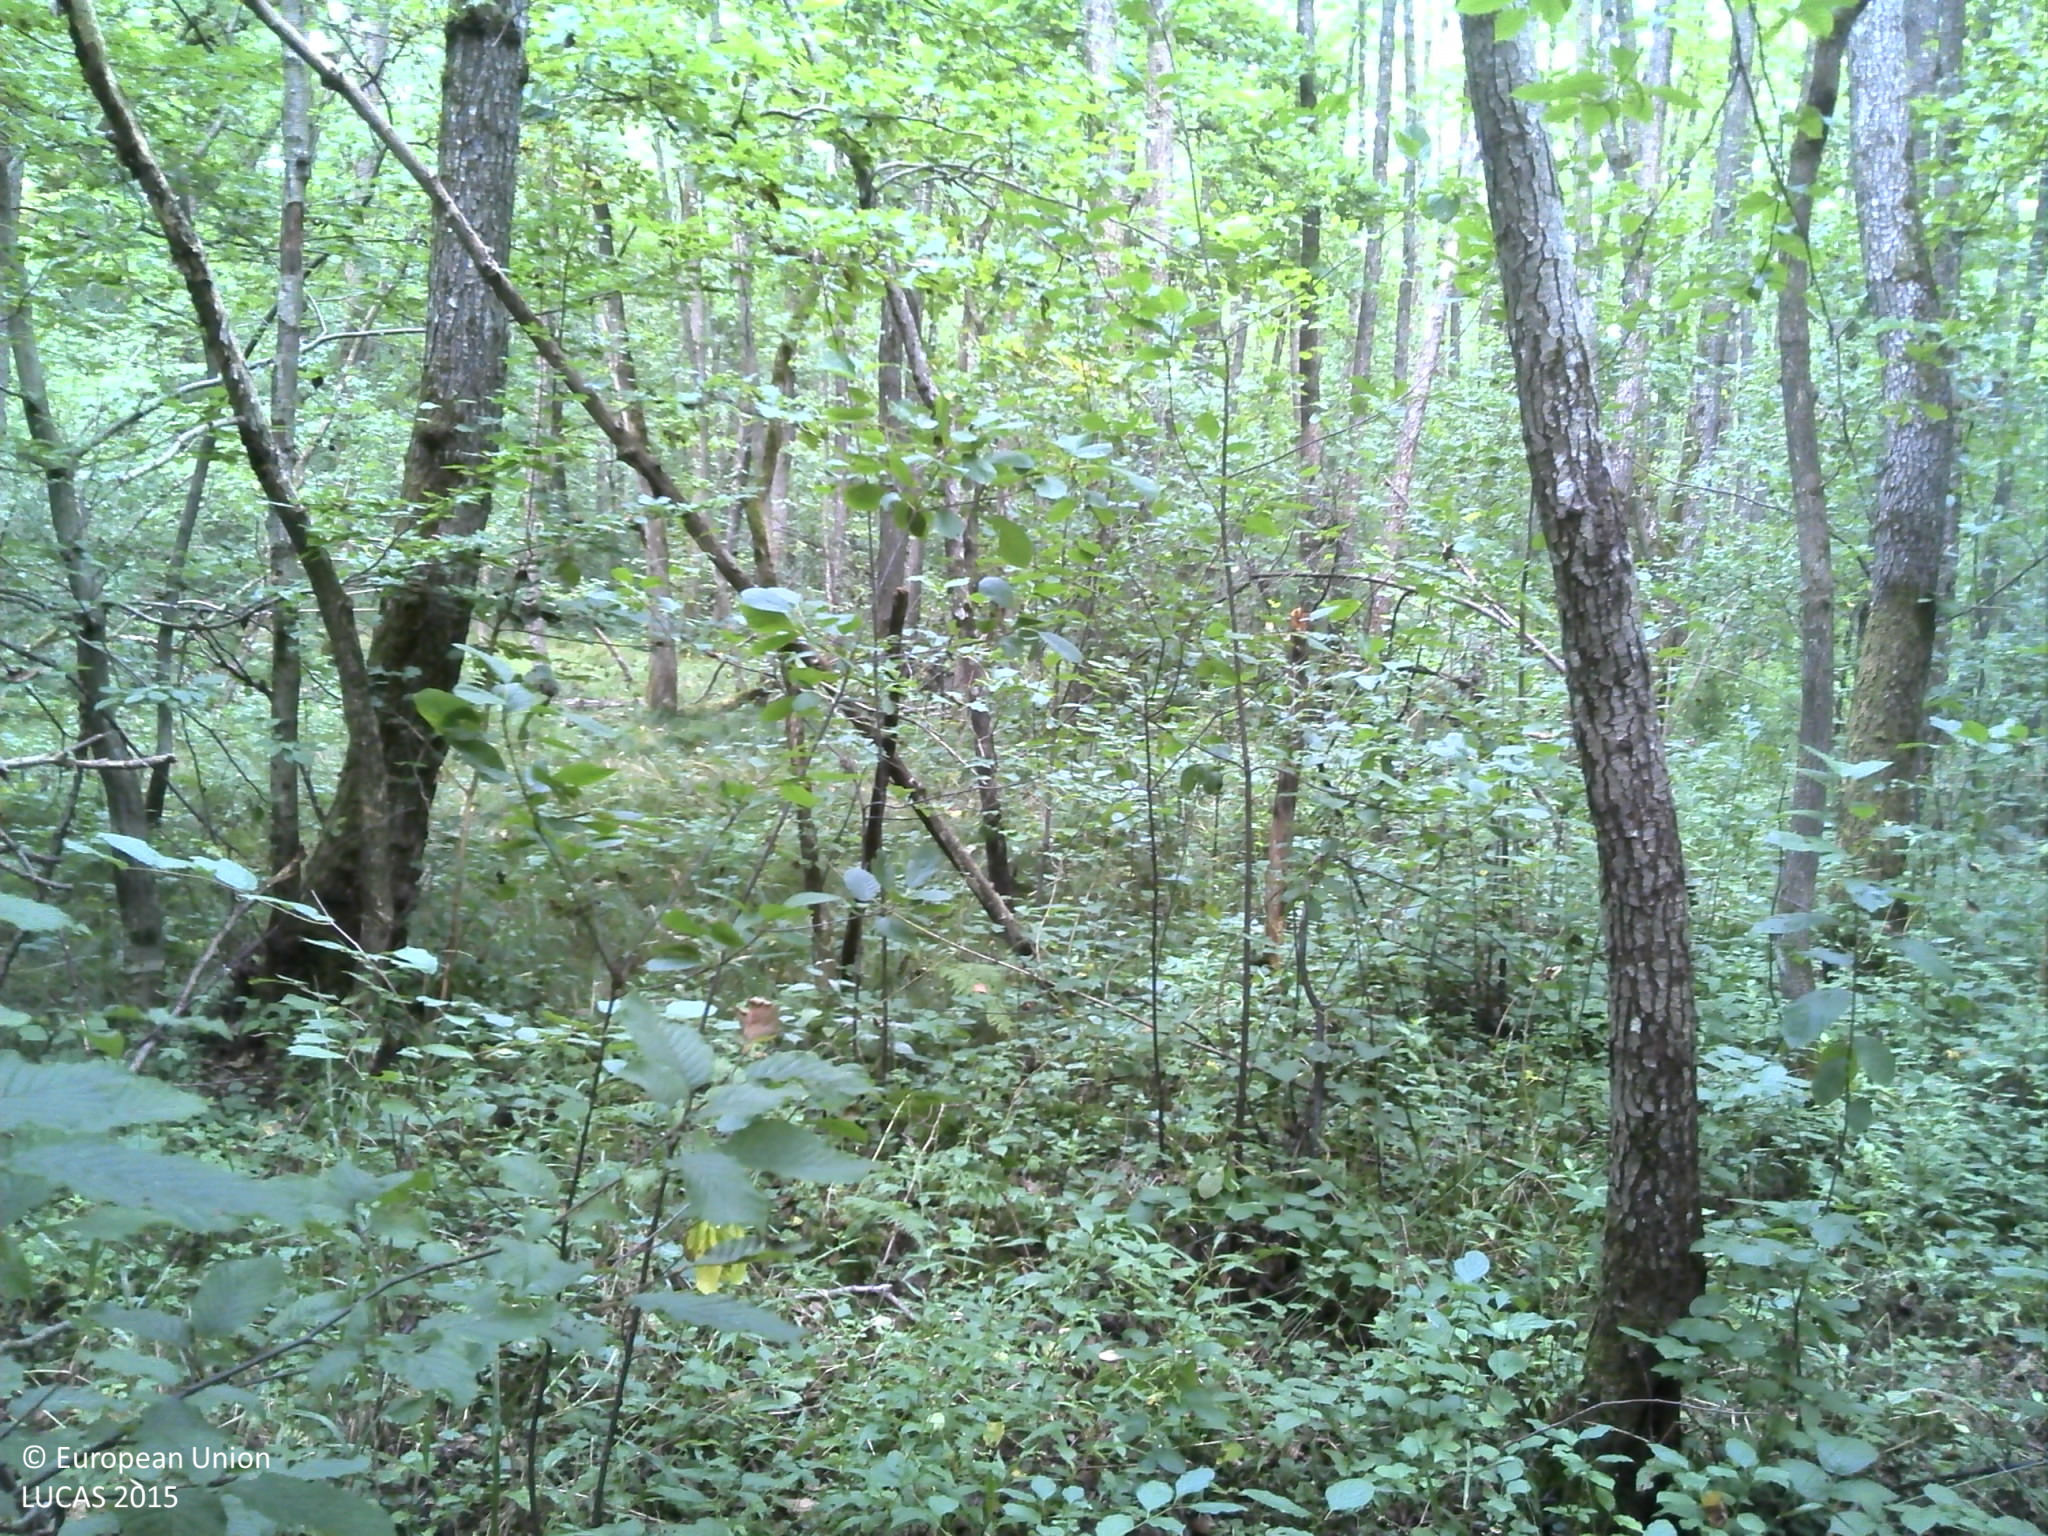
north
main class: Woodland
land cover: Broadleaved woodland
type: beech forest
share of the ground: > 75 %
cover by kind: broadleaved forest trees 100 %
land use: Forestry
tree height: > 5 m
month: August
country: HR
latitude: 45.4995
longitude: 15.6145
